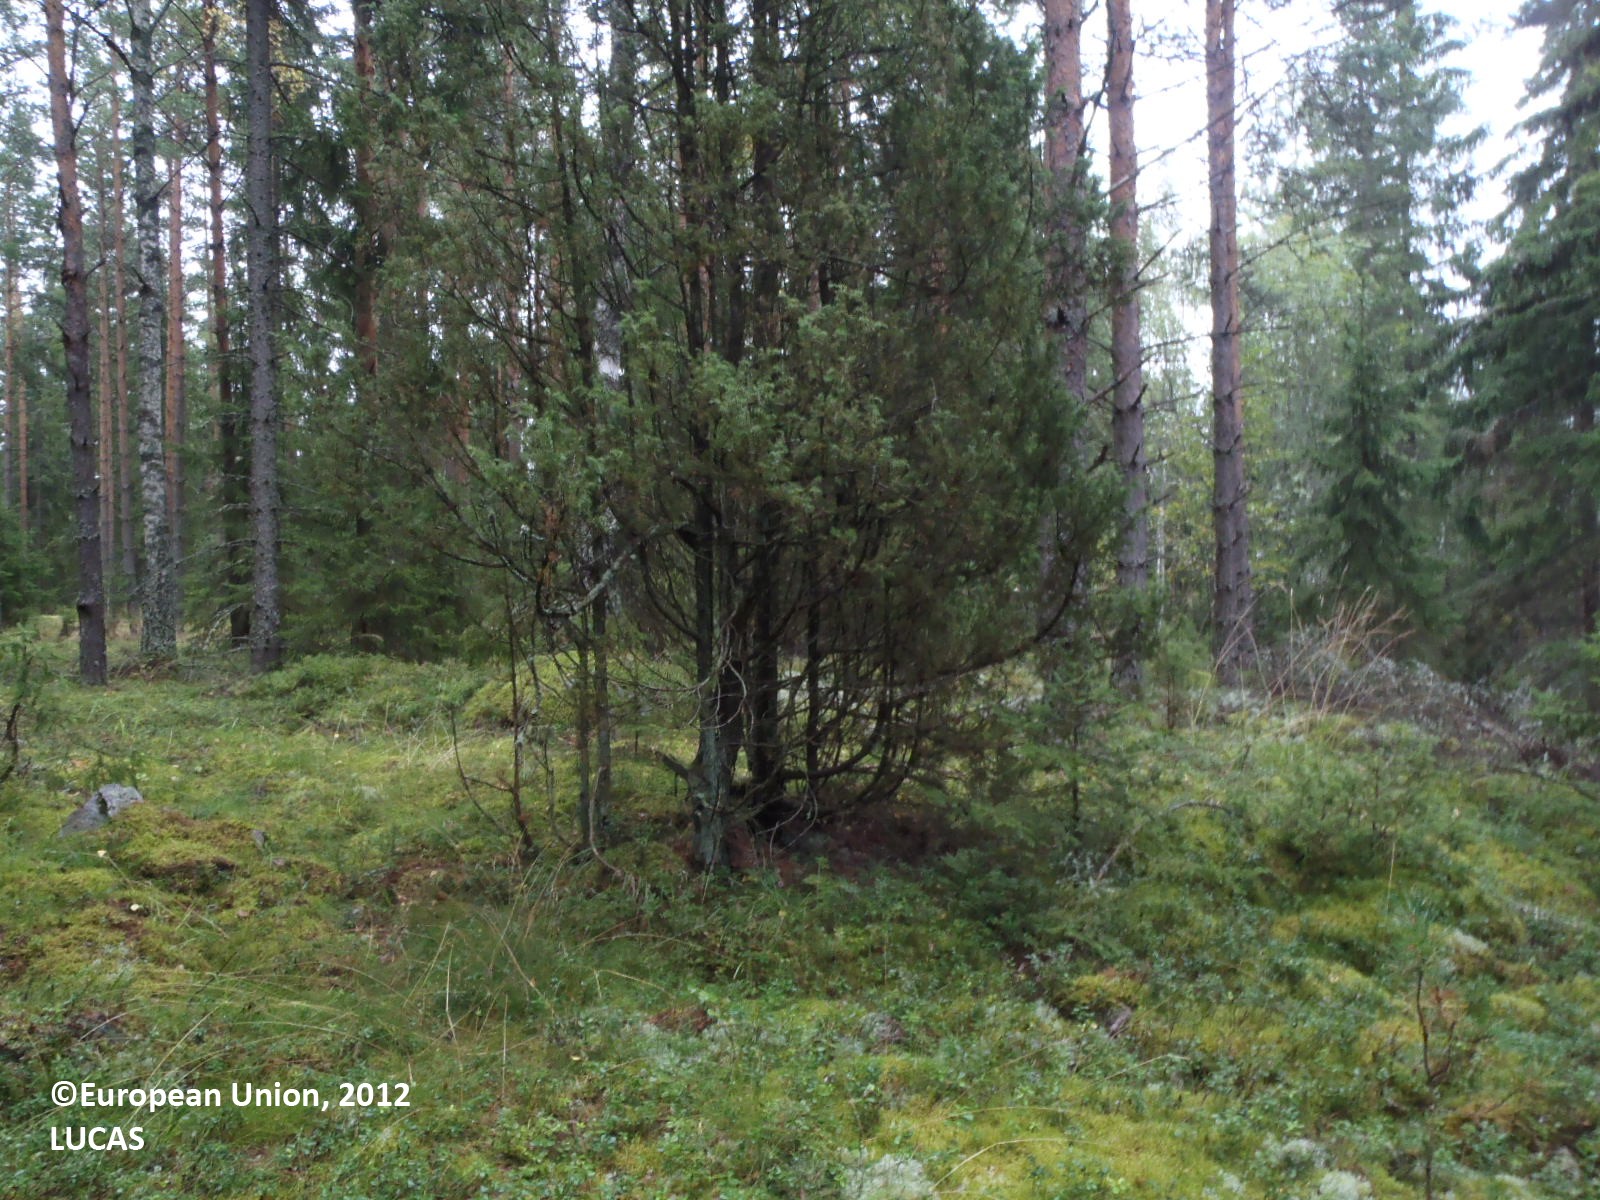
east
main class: Woodland
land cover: Pine dominated coniferous woodland
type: boreal forest
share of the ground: 50 - 75 %
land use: Forestry
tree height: > 5 m
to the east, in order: Pine dominated coniferous woodland; Pine dominated mixed woodland; Spruce dominated coniferous woodland; Tracks; Grass margins; Ditches and canals; Abandoned hedges; Fences; Temporary grasslands
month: September
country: FI
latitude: 60.8531
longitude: 22.8283
